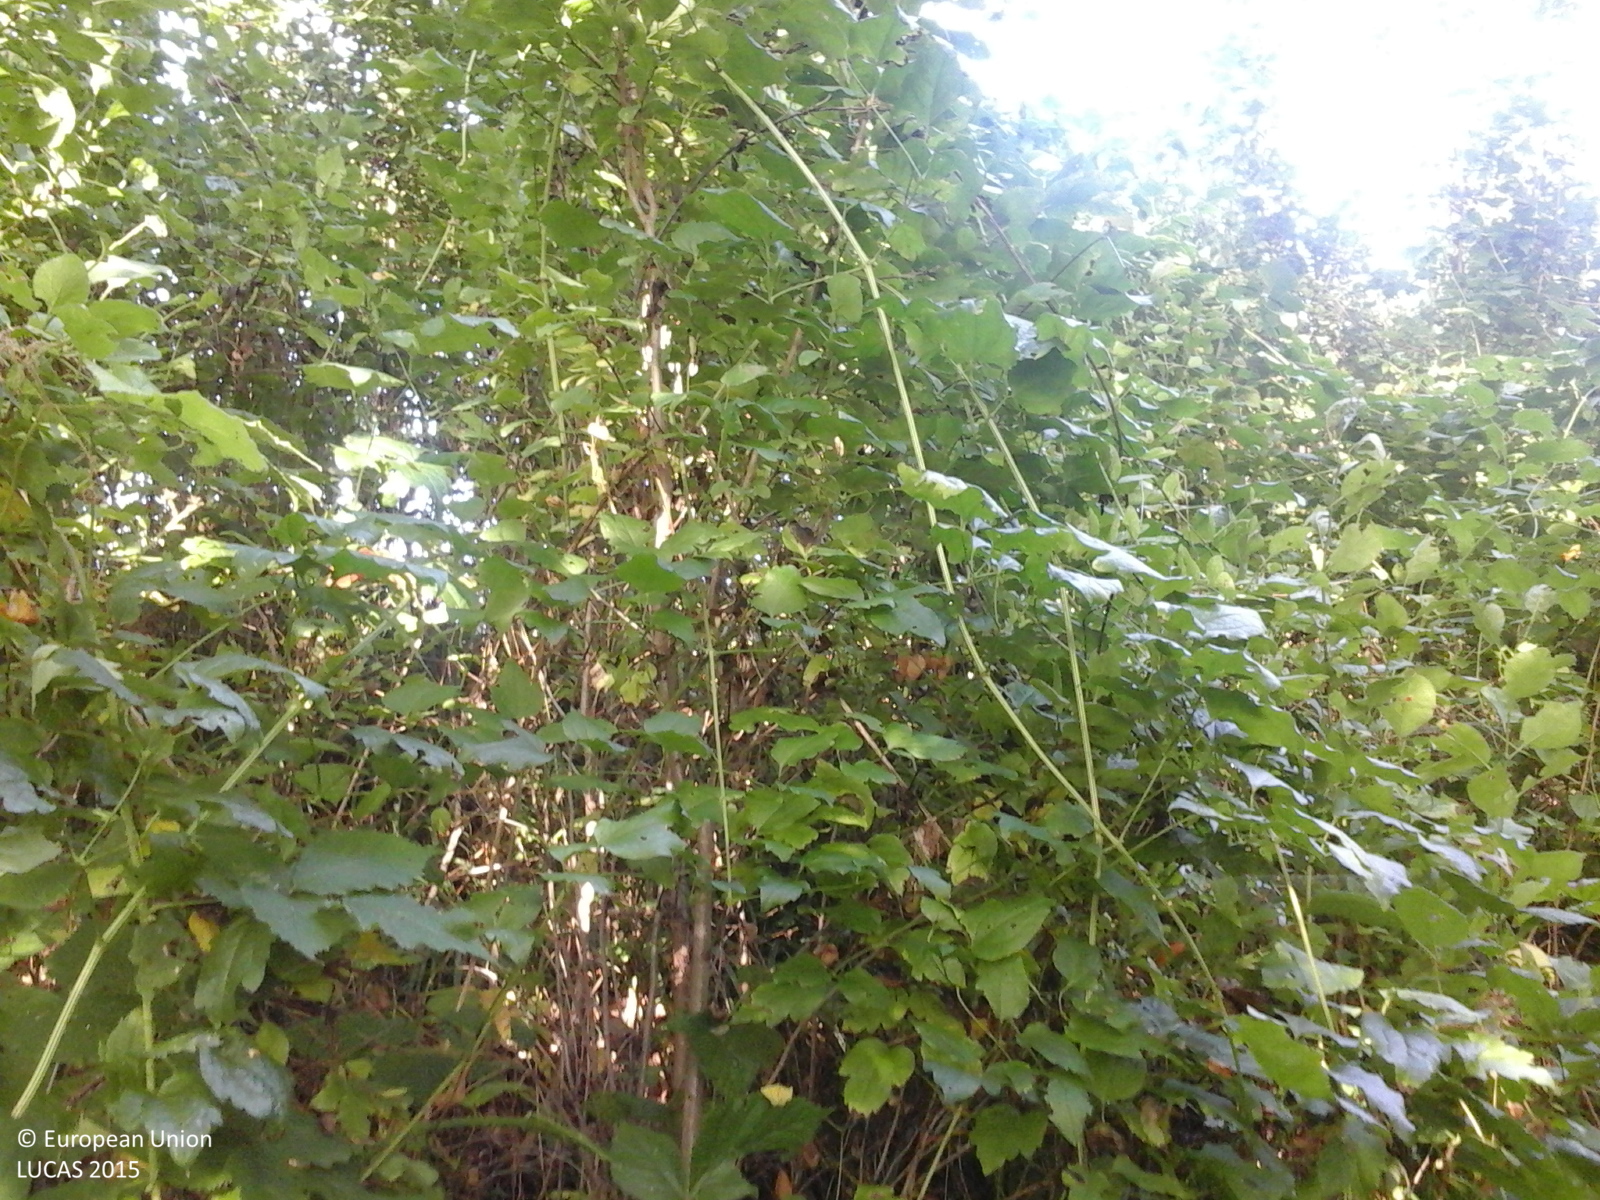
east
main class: Woodland
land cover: Broadleaved woodland
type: mesophytic deciduous forest
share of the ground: > 75 %
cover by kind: broadleaved forest trees 100 %
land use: Forestry
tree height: > 5 m
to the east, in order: Broadleaved woodland; Grassland without tree/shrub cover; Lines of trees; Grassland without tree/shrub cover; Lines of trees; Fences; Lines of trees; Grassland without tree/shrub cover; Other fruit trees and berries; Ditches and canals; Other fruit trees and berries; Grassland without tree/shrub cover; Tracks; Broadleaved woodland; Grassland without tree/shrub cover
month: September
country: RO
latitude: 47.2900
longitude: 23.8438
